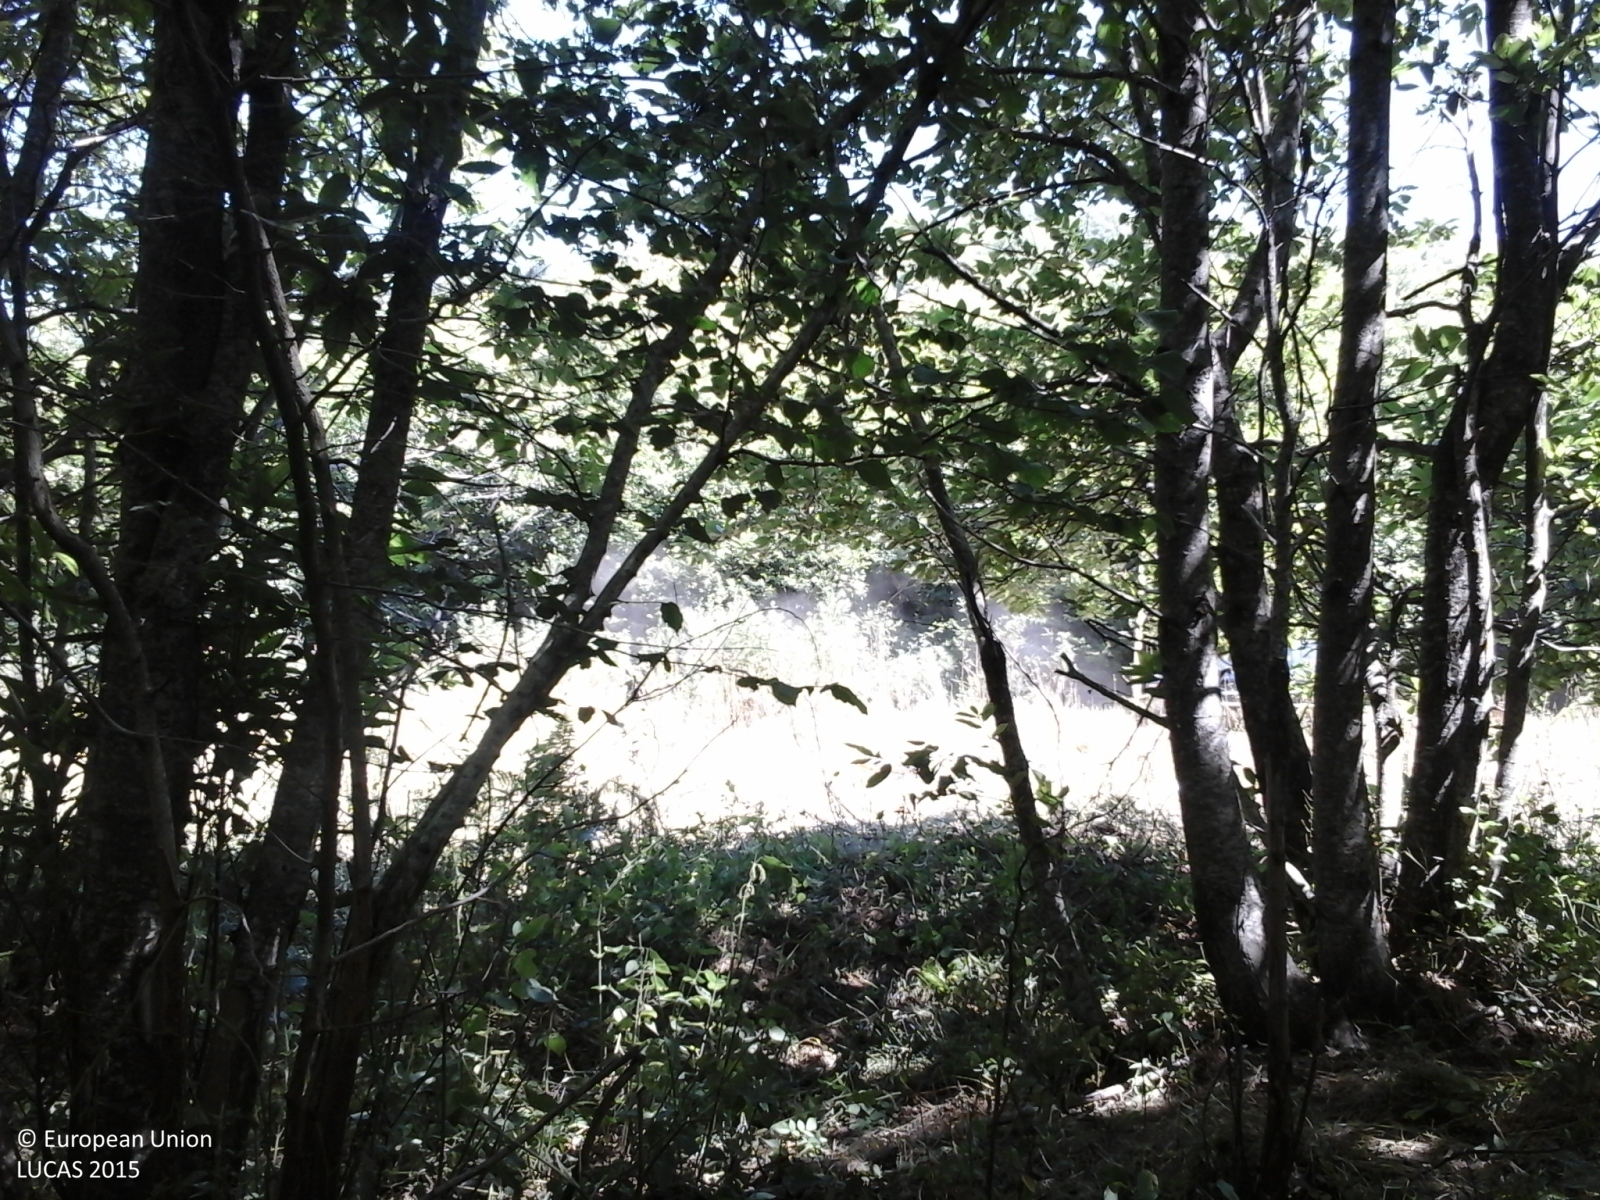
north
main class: Woodland
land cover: Broadleaved woodland
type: thermophilous deciduous forest
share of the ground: > 75 %
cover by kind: broadleaved forest trees 80 %, shrubs 20 %
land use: Forestry
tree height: > 5 m
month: July
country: IT
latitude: 40.8799
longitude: 14.6923
